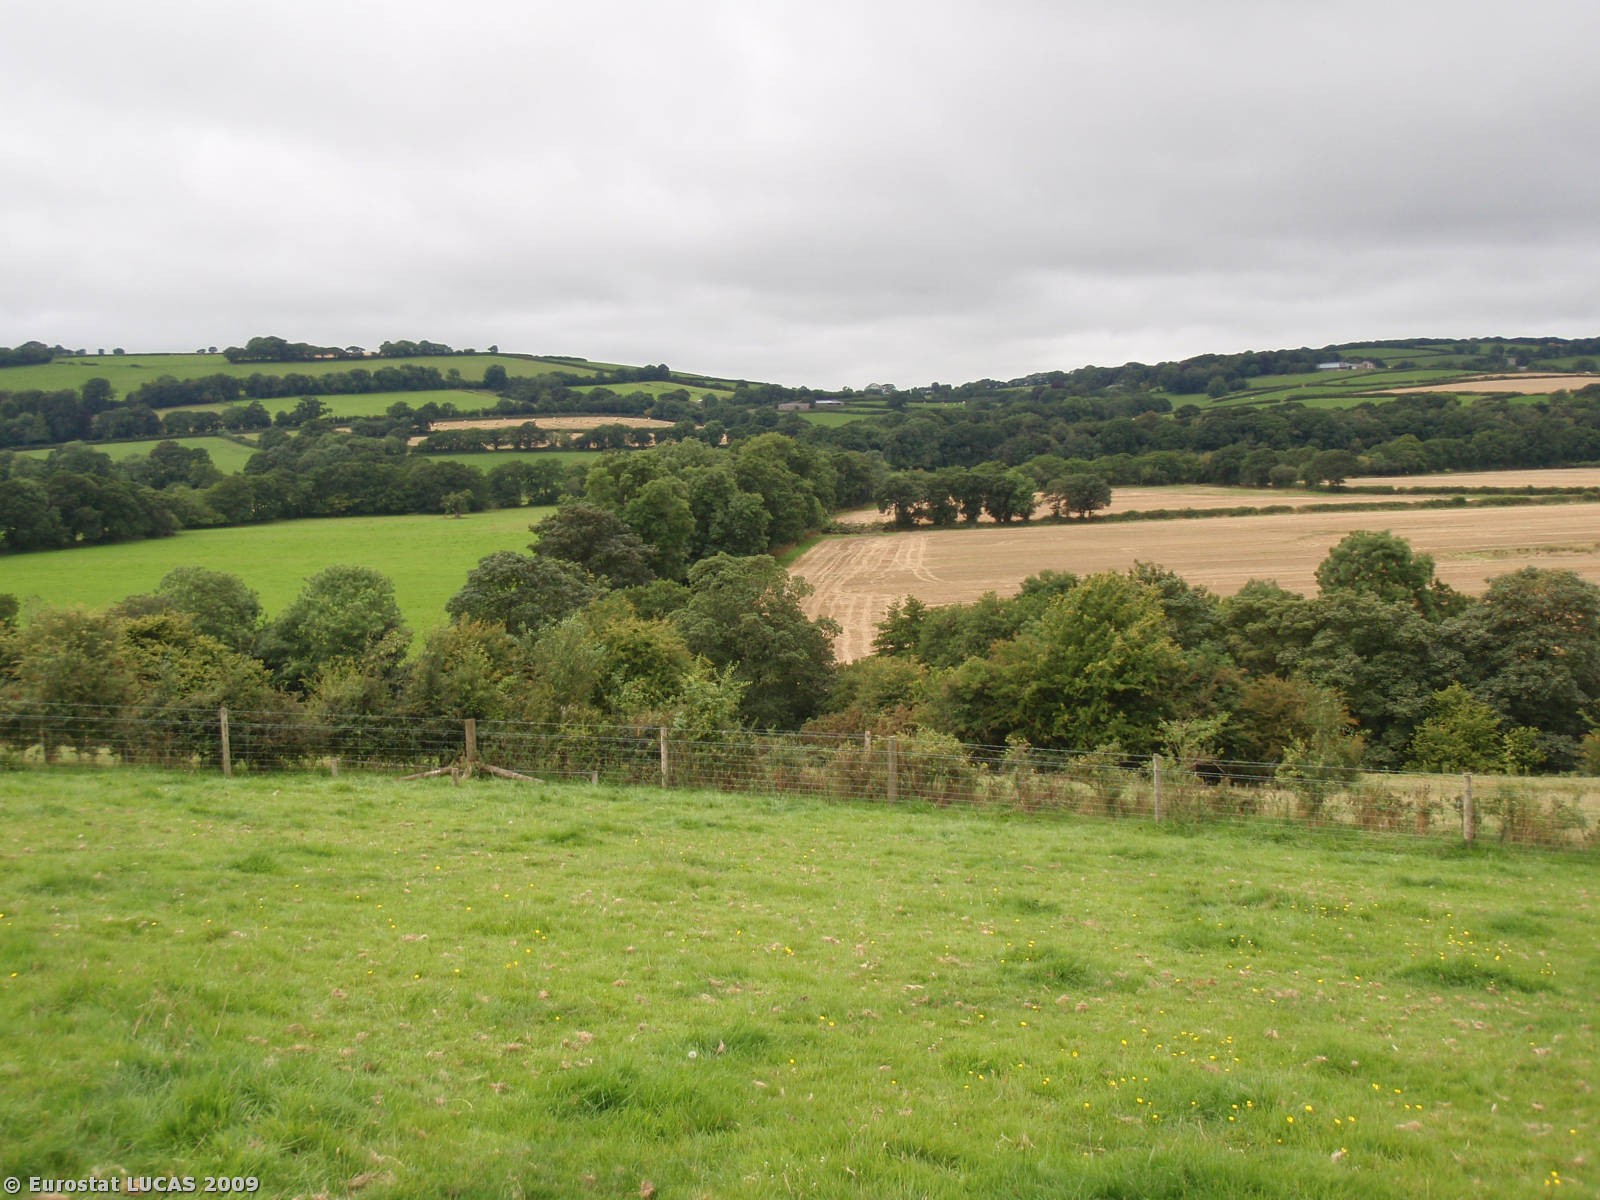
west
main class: Grassland
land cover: Grassland without tree/shrub cover
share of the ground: > 75 %
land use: Agriculture (excluding fallow land and kitchen gardens)
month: August
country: GB
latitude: 50.6101
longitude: -4.3022
